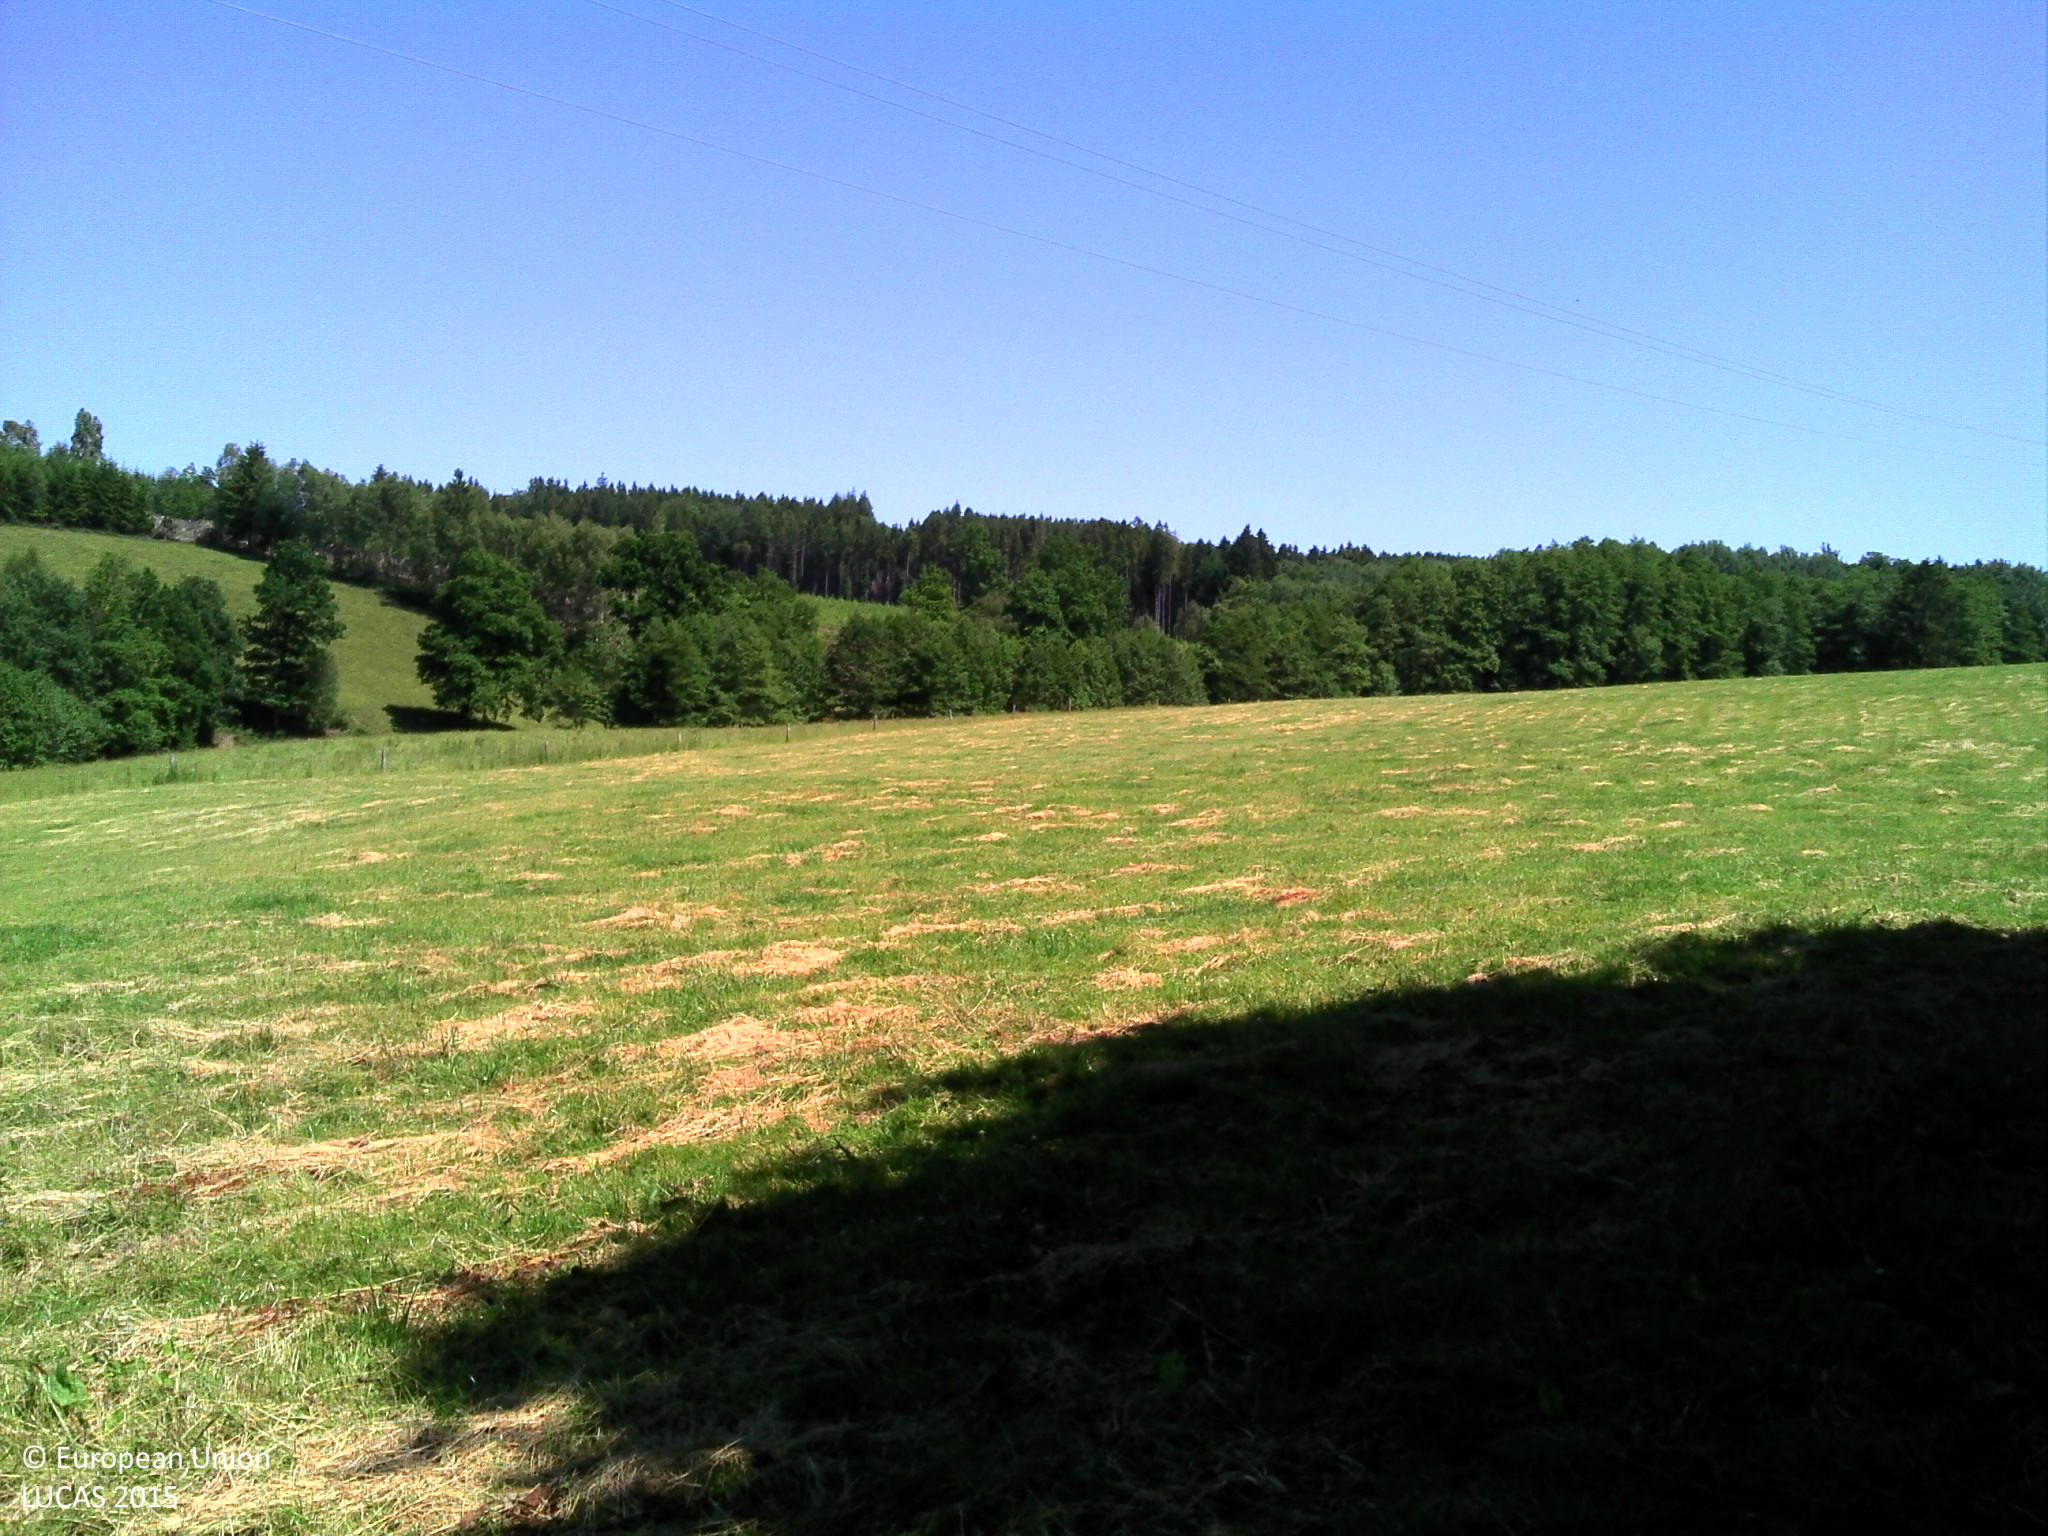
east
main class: Grassland
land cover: Grassland without tree/shrub cover
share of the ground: > 75 %
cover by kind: herbaceous plants 100 %
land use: Agriculture (excluding fallow land and kitchen gardens)
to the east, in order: Grassland without tree/shrub cover; Fences; Grassland without tree/shrub cover; Fences; Broadleaved woodland; Rivers and streams; Broadleaved woodland; Grassland without tree/shrub cover
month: June
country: BE
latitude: 50.0611
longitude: 5.5423
